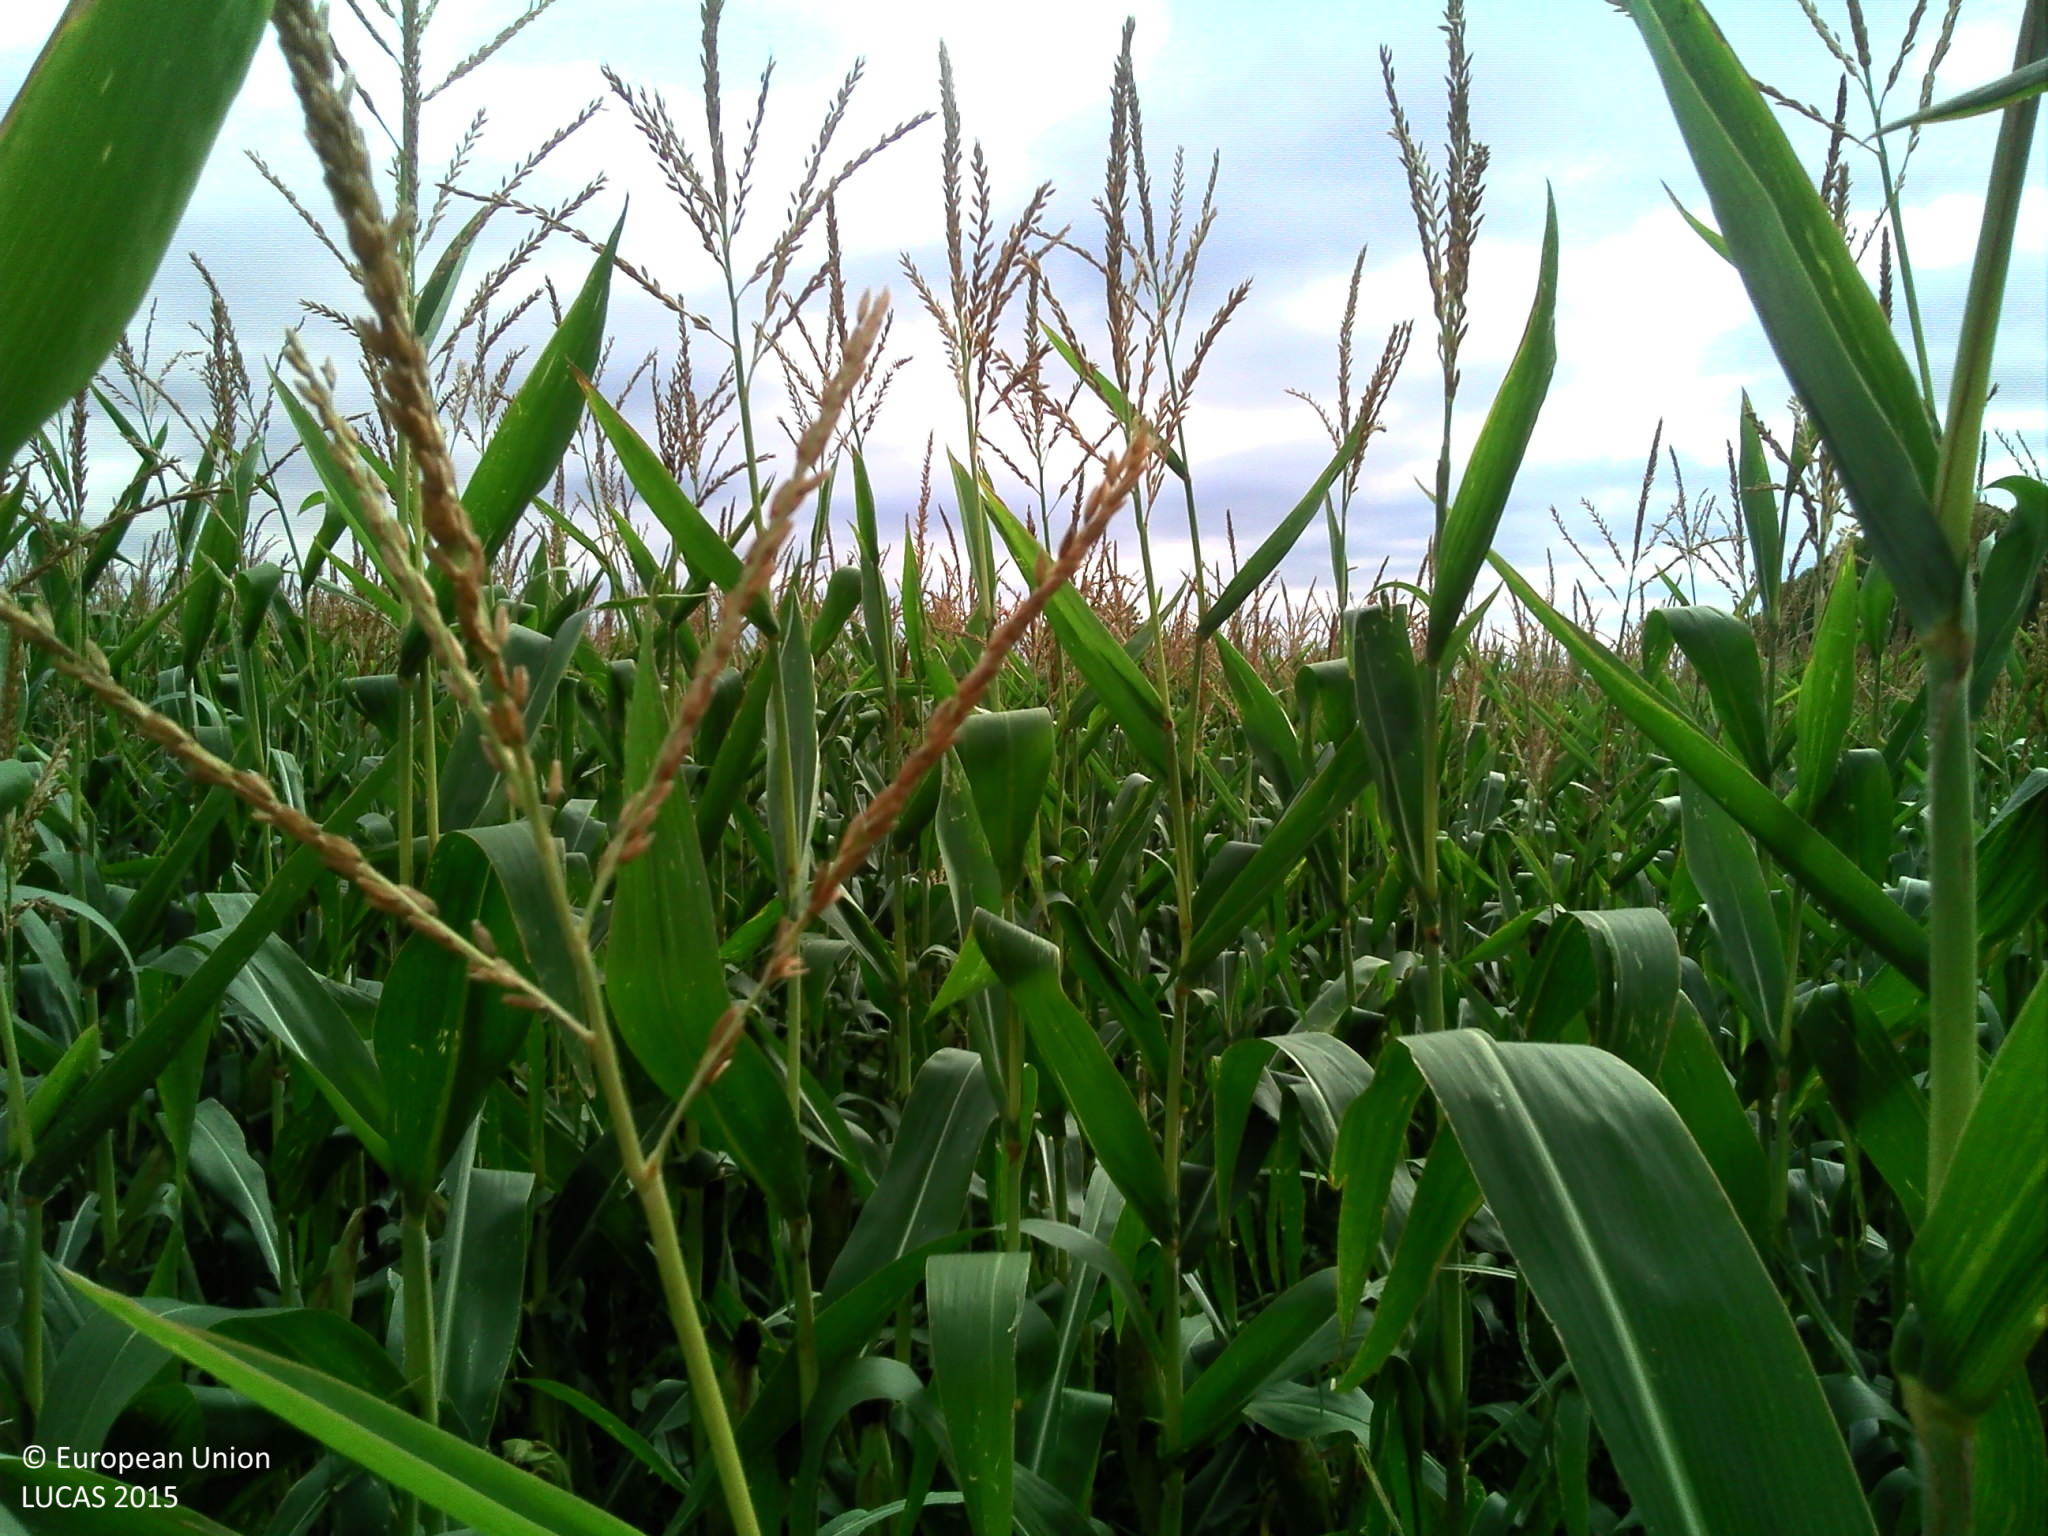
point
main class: Cropland
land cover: Maize
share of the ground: > 75 %
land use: Agriculture (excluding fallow land and kitchen gardens)
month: August
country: FR
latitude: 48.6857
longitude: 7.7052
